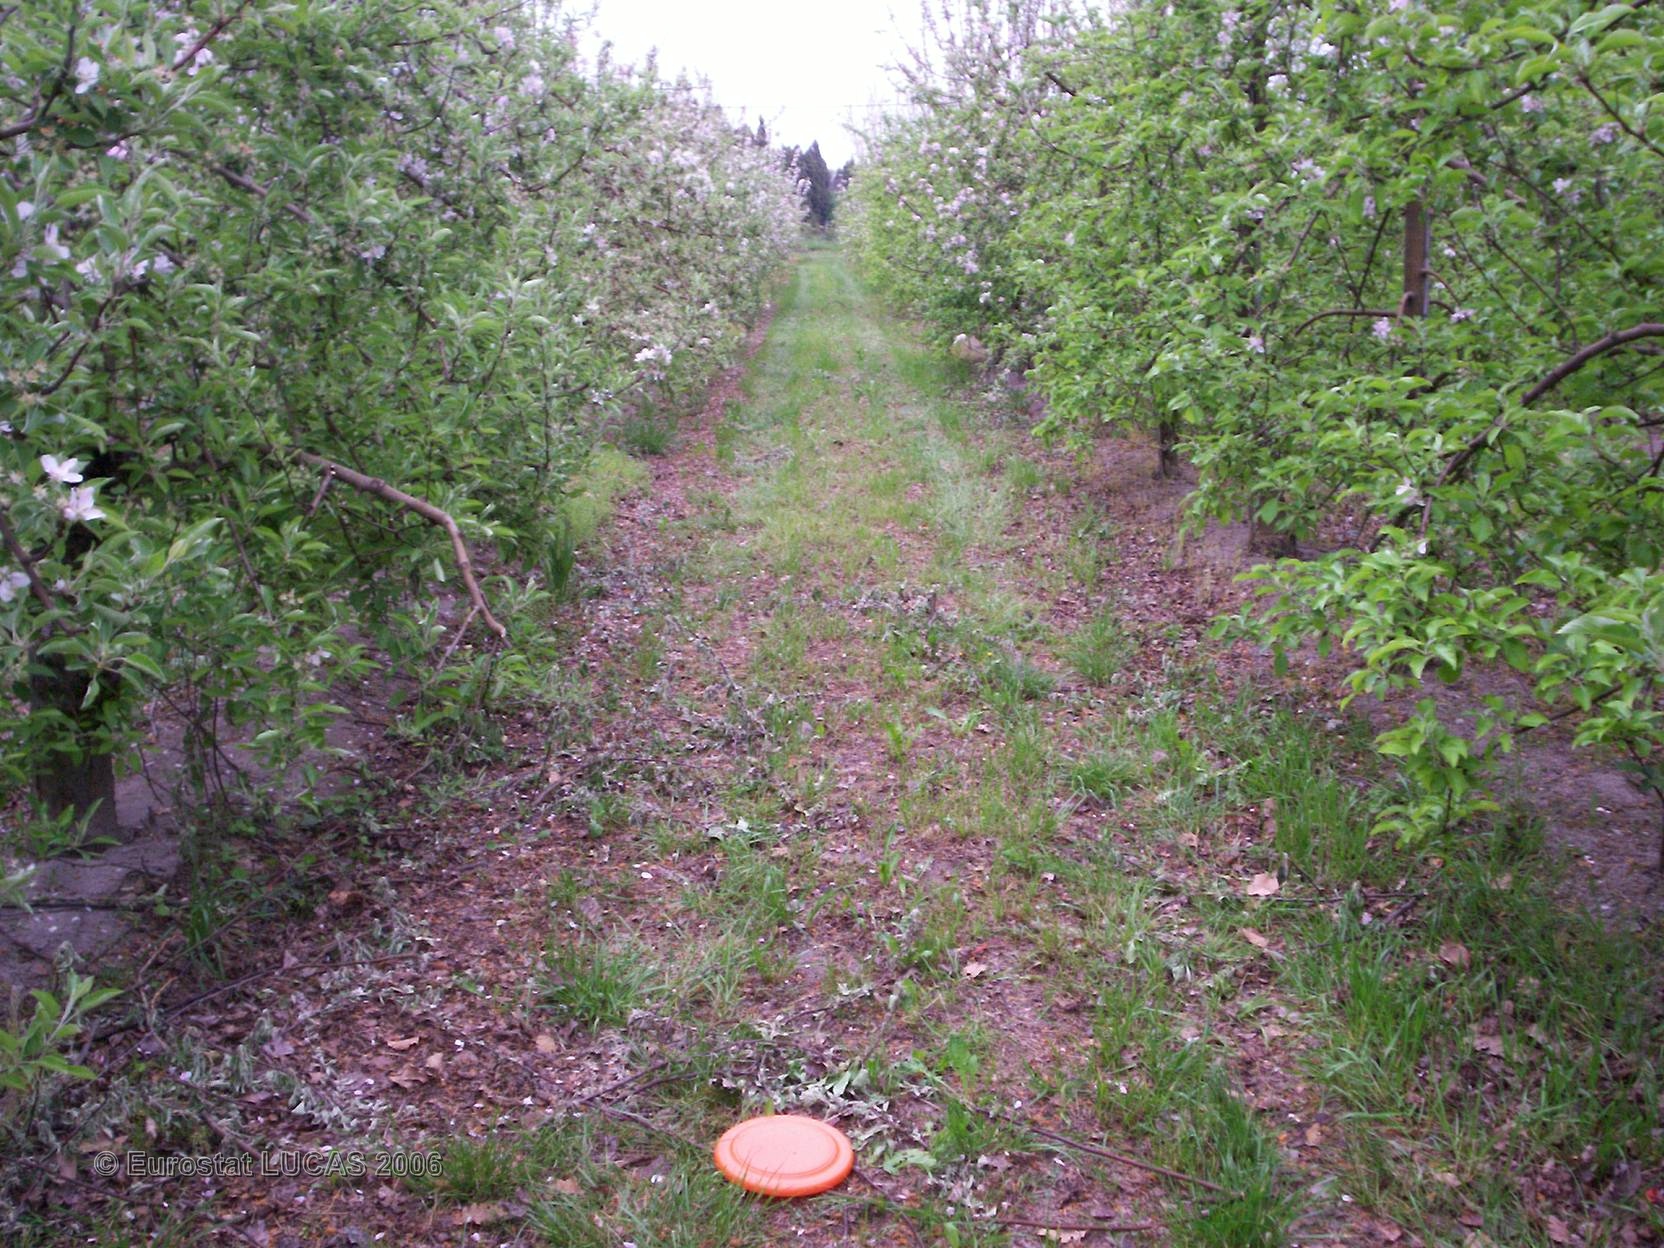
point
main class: Cropland
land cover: Apple fruit
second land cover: Grassland with sparse tree/shrub cover
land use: Agriculture (excluding fallow land and kitchen gardens)
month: April
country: FR
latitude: 43.8287
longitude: 4.9230
